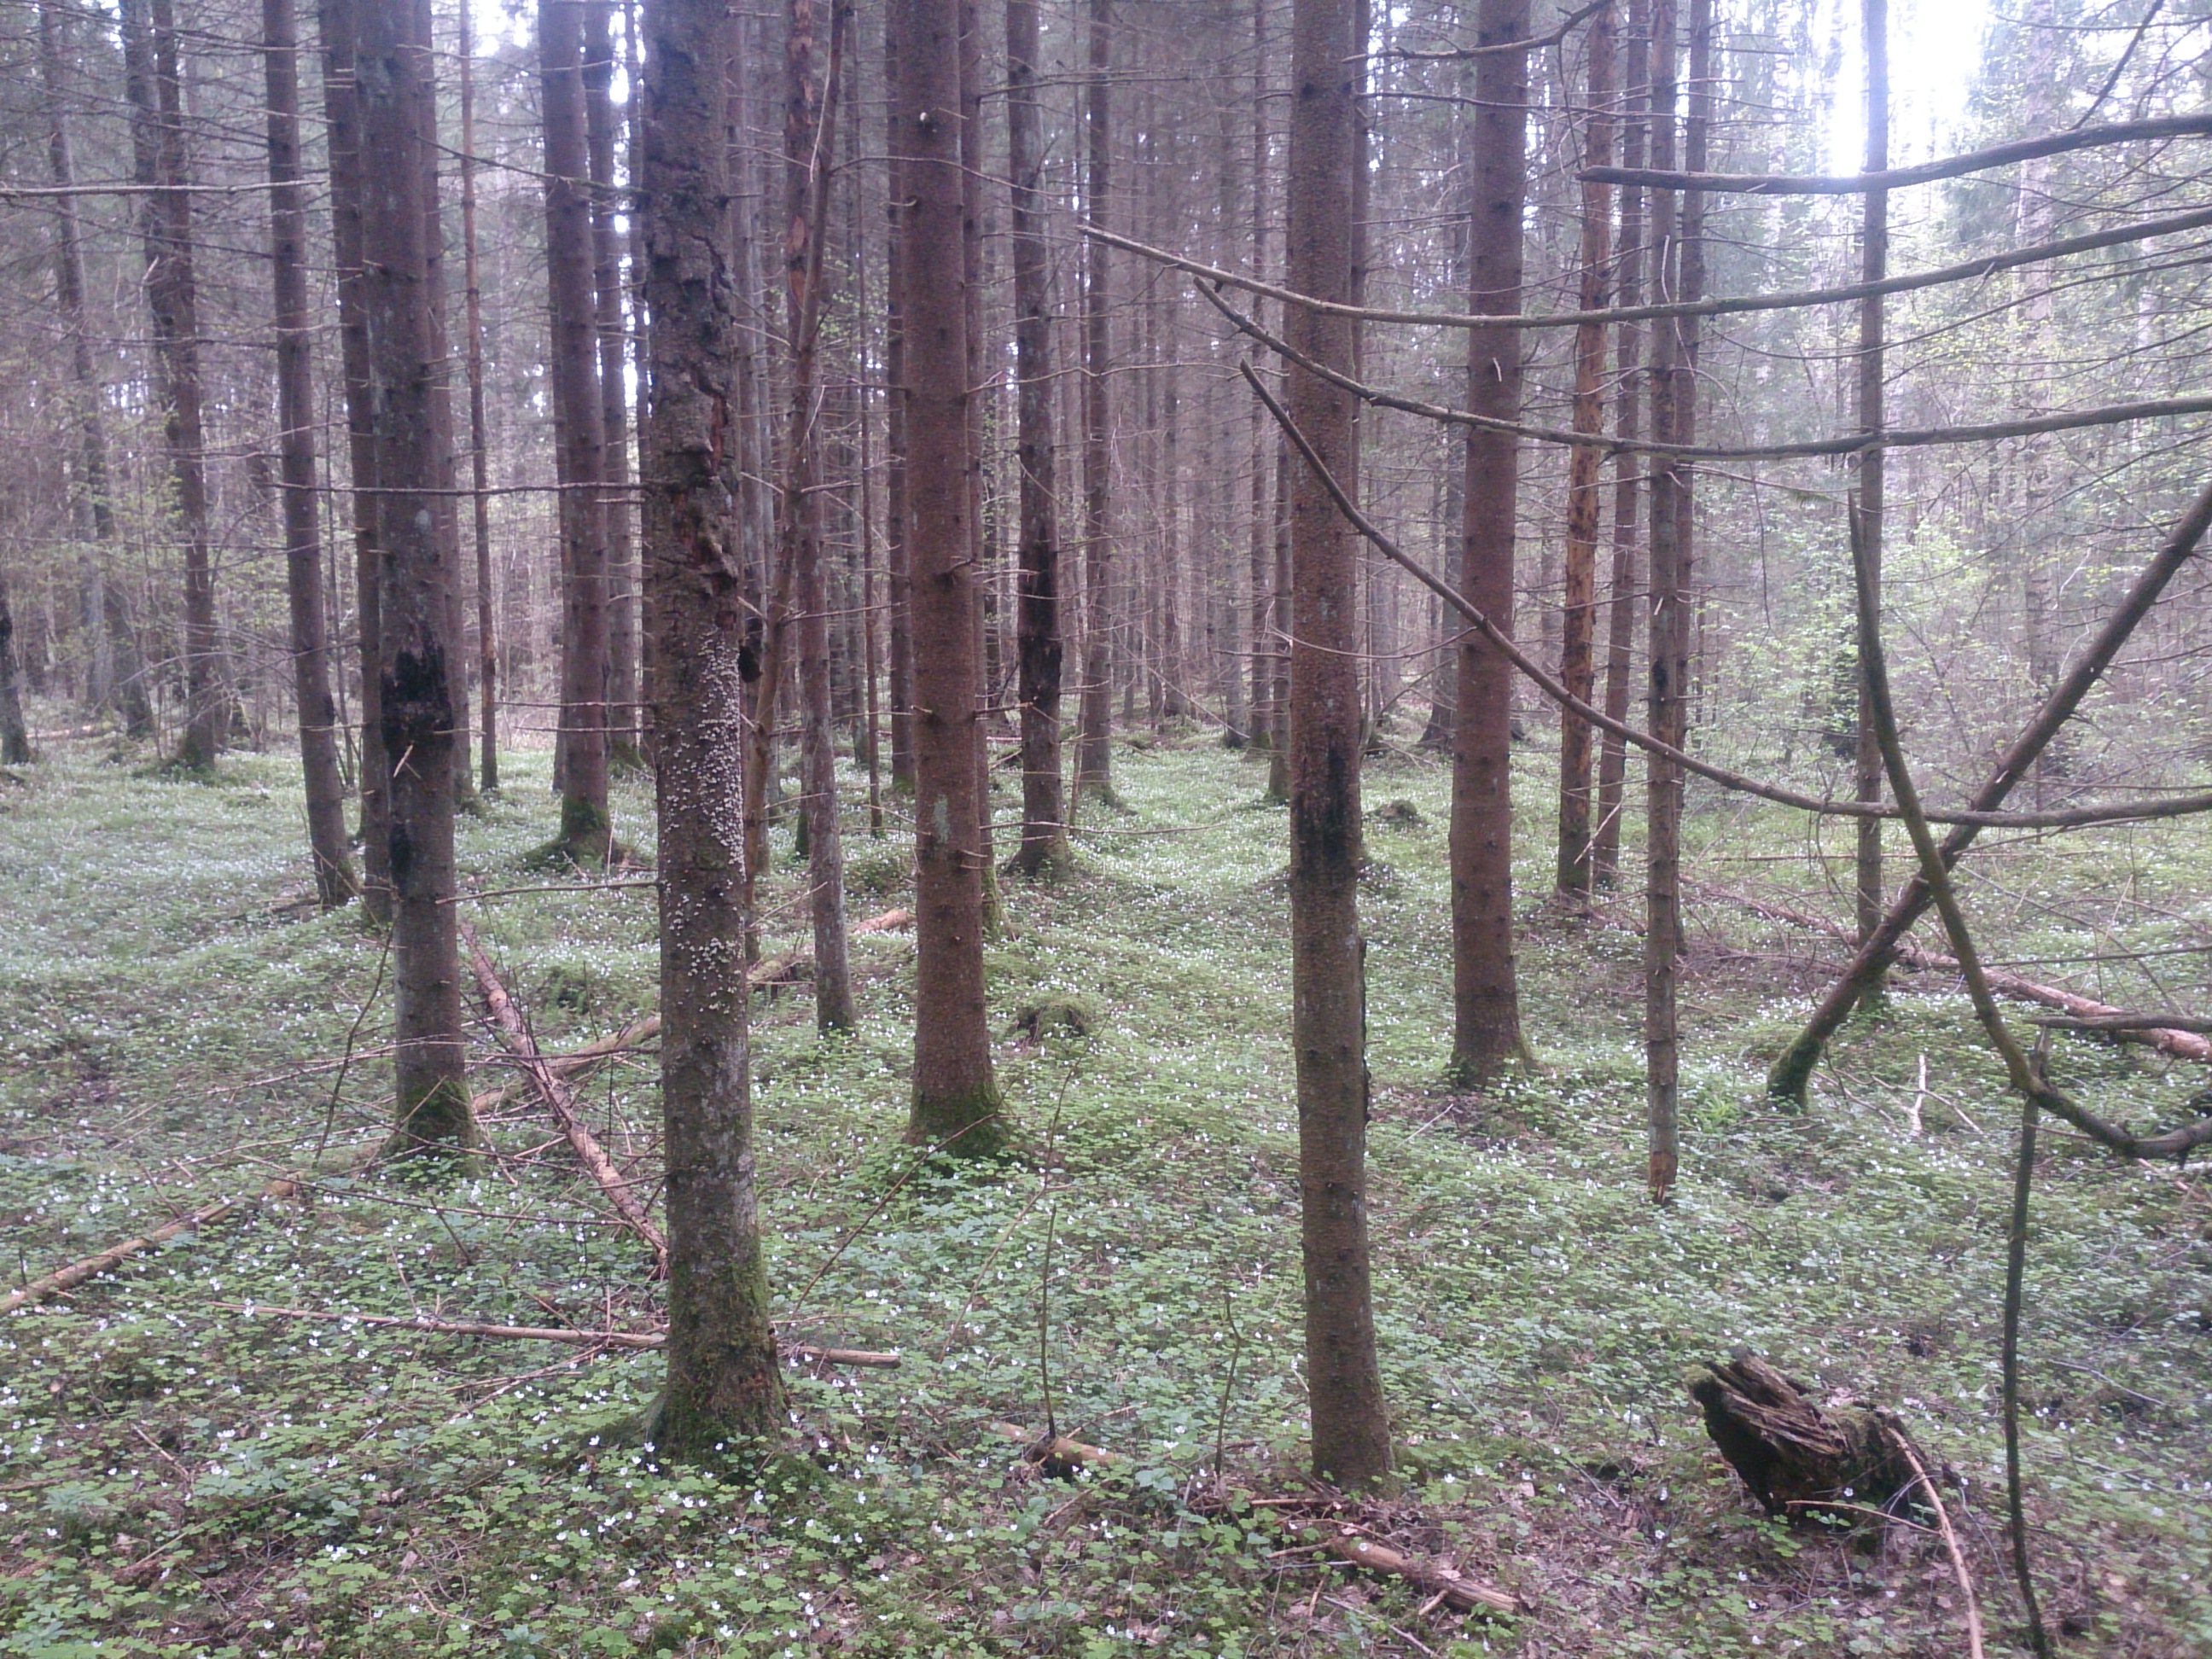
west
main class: Woodland
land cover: Spruce dominated mixed woodland
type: hemiboreal forest and nemoral coniferous forest and mixed broadleaved-coniferous forest
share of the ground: > 75 %
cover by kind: coniferous forest trees 60 %, broadleaved forest trees 40 %
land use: Forestry
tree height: > 5 m
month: May
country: LV
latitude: 56.7111
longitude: 24.0194
